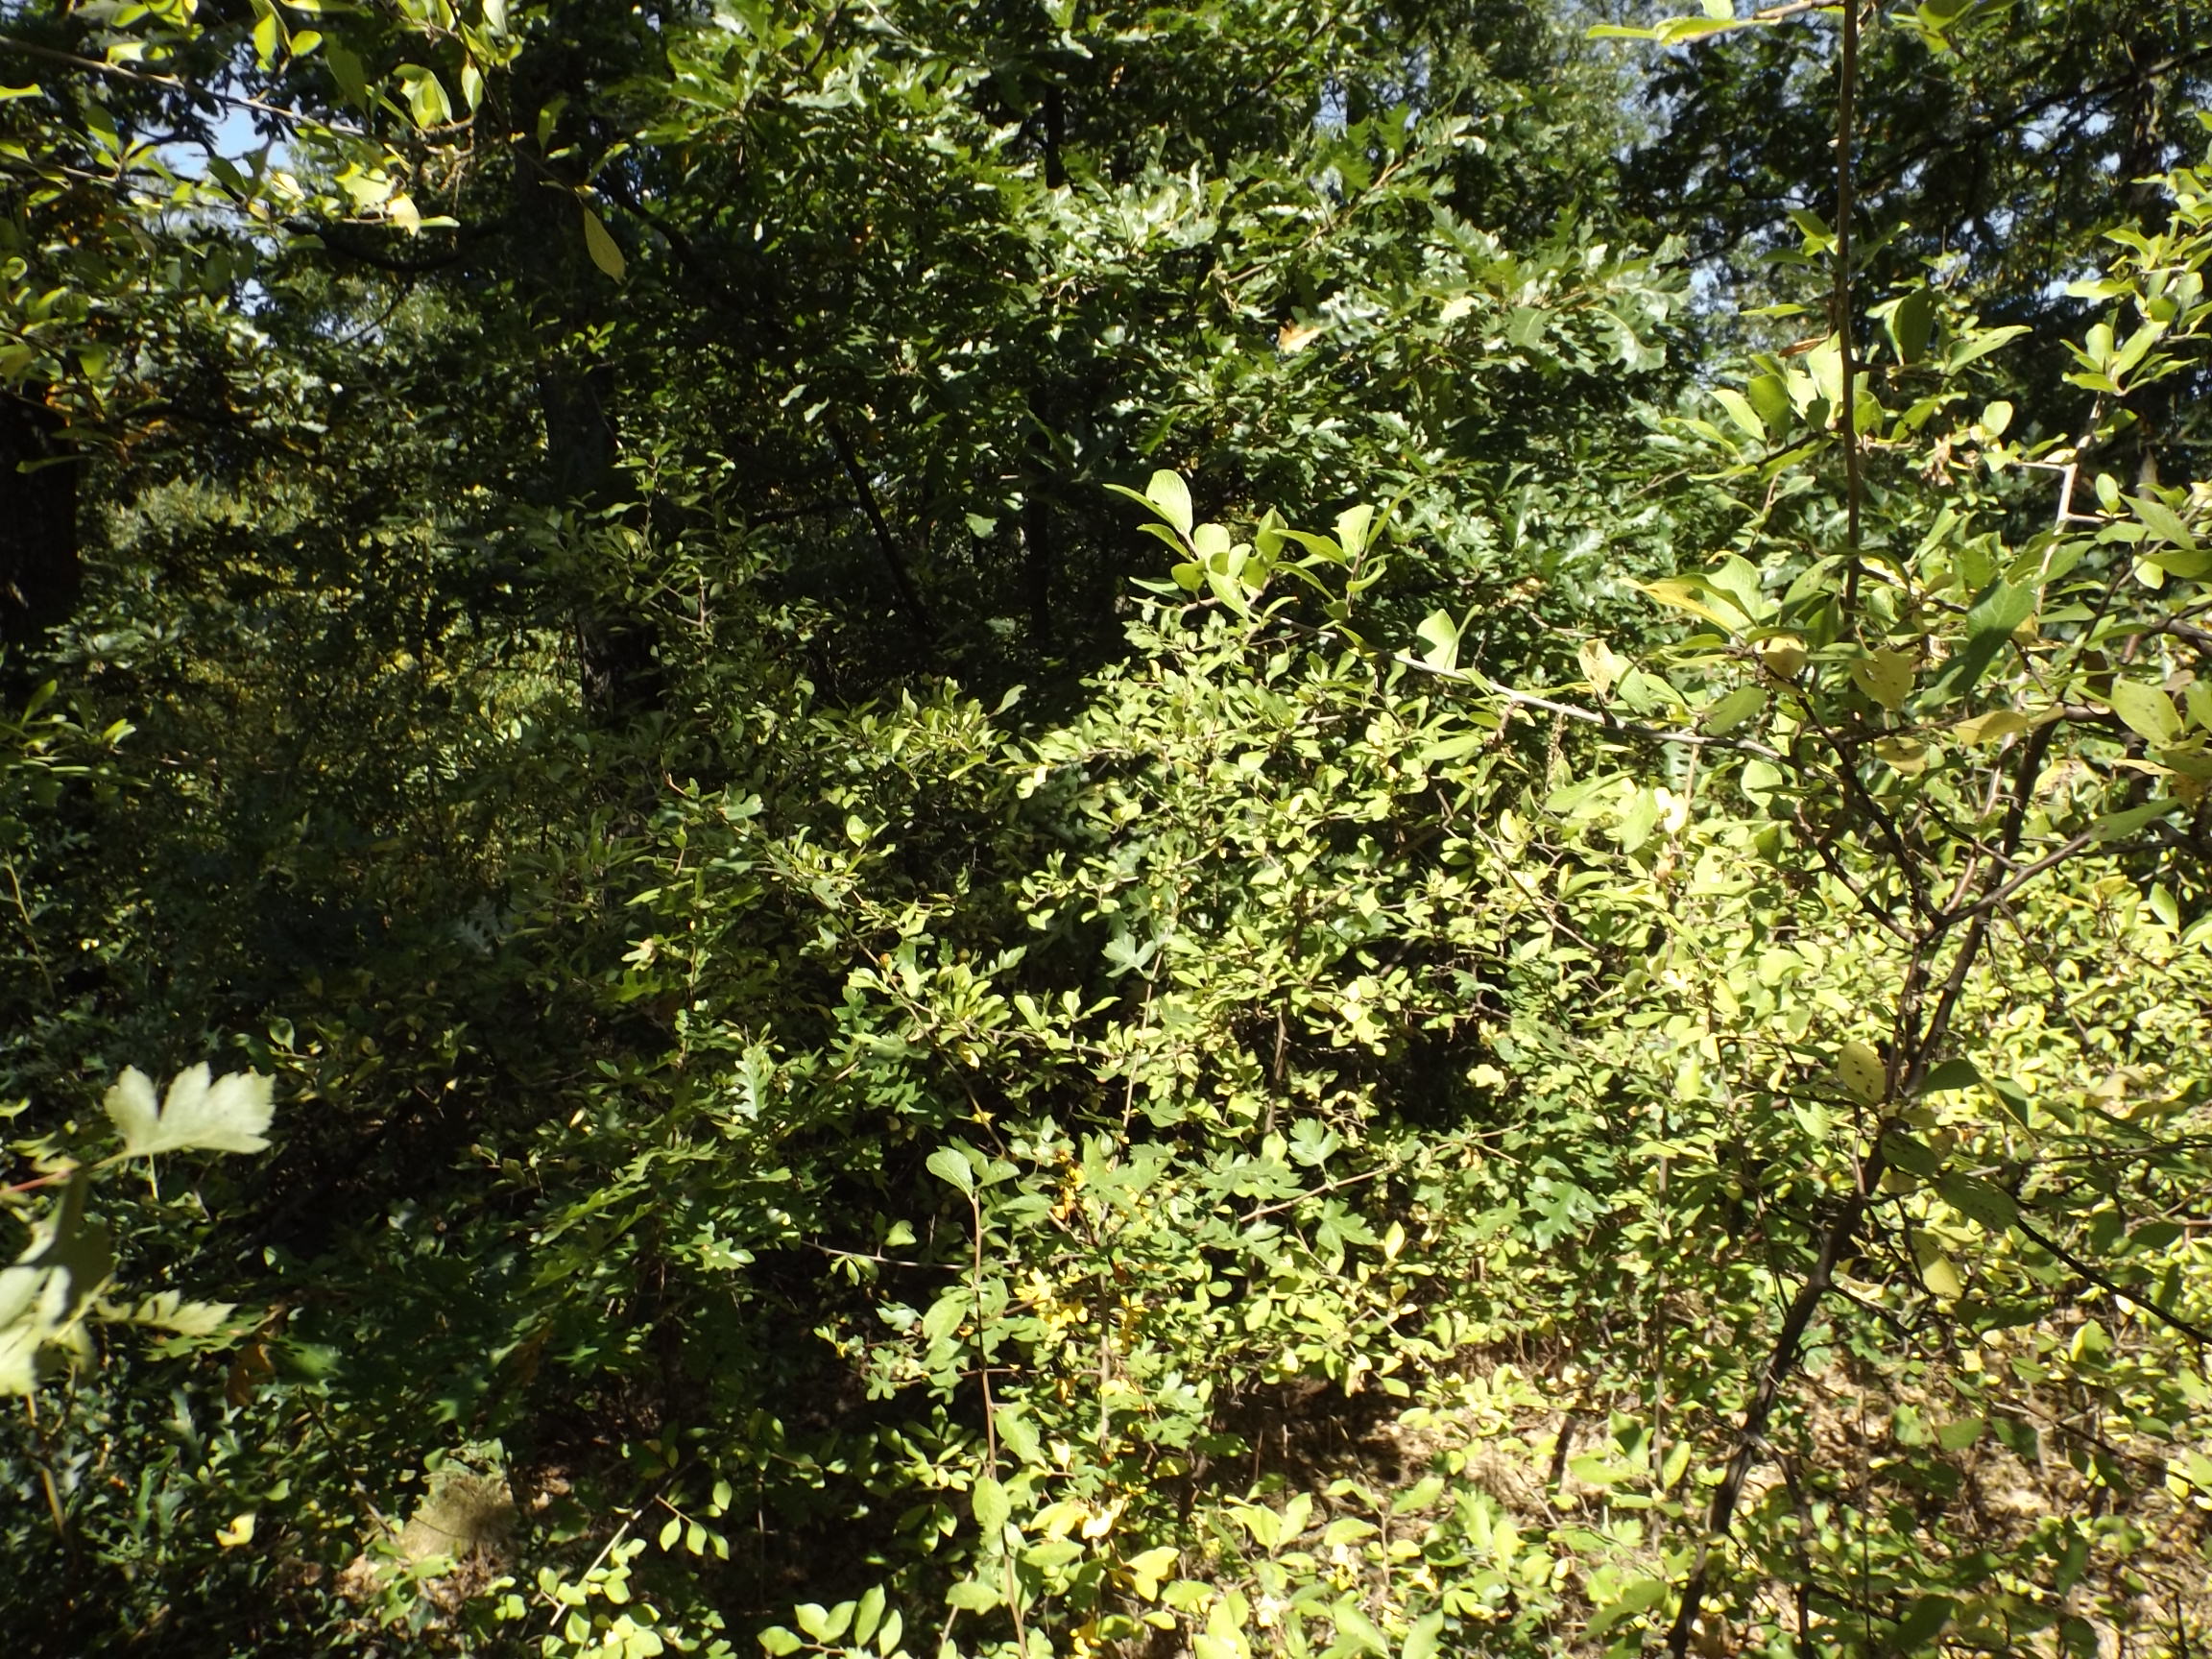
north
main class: Woodland
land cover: Broadleaved woodland
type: mesophytic deciduous forest
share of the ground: > 75 %
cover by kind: broadleaved forest trees 85 %, herbaceous plants 10 %, shrubs 5 %
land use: Forestry
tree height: > 5 m
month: September
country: BG
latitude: 43.4112
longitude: 27.6582
